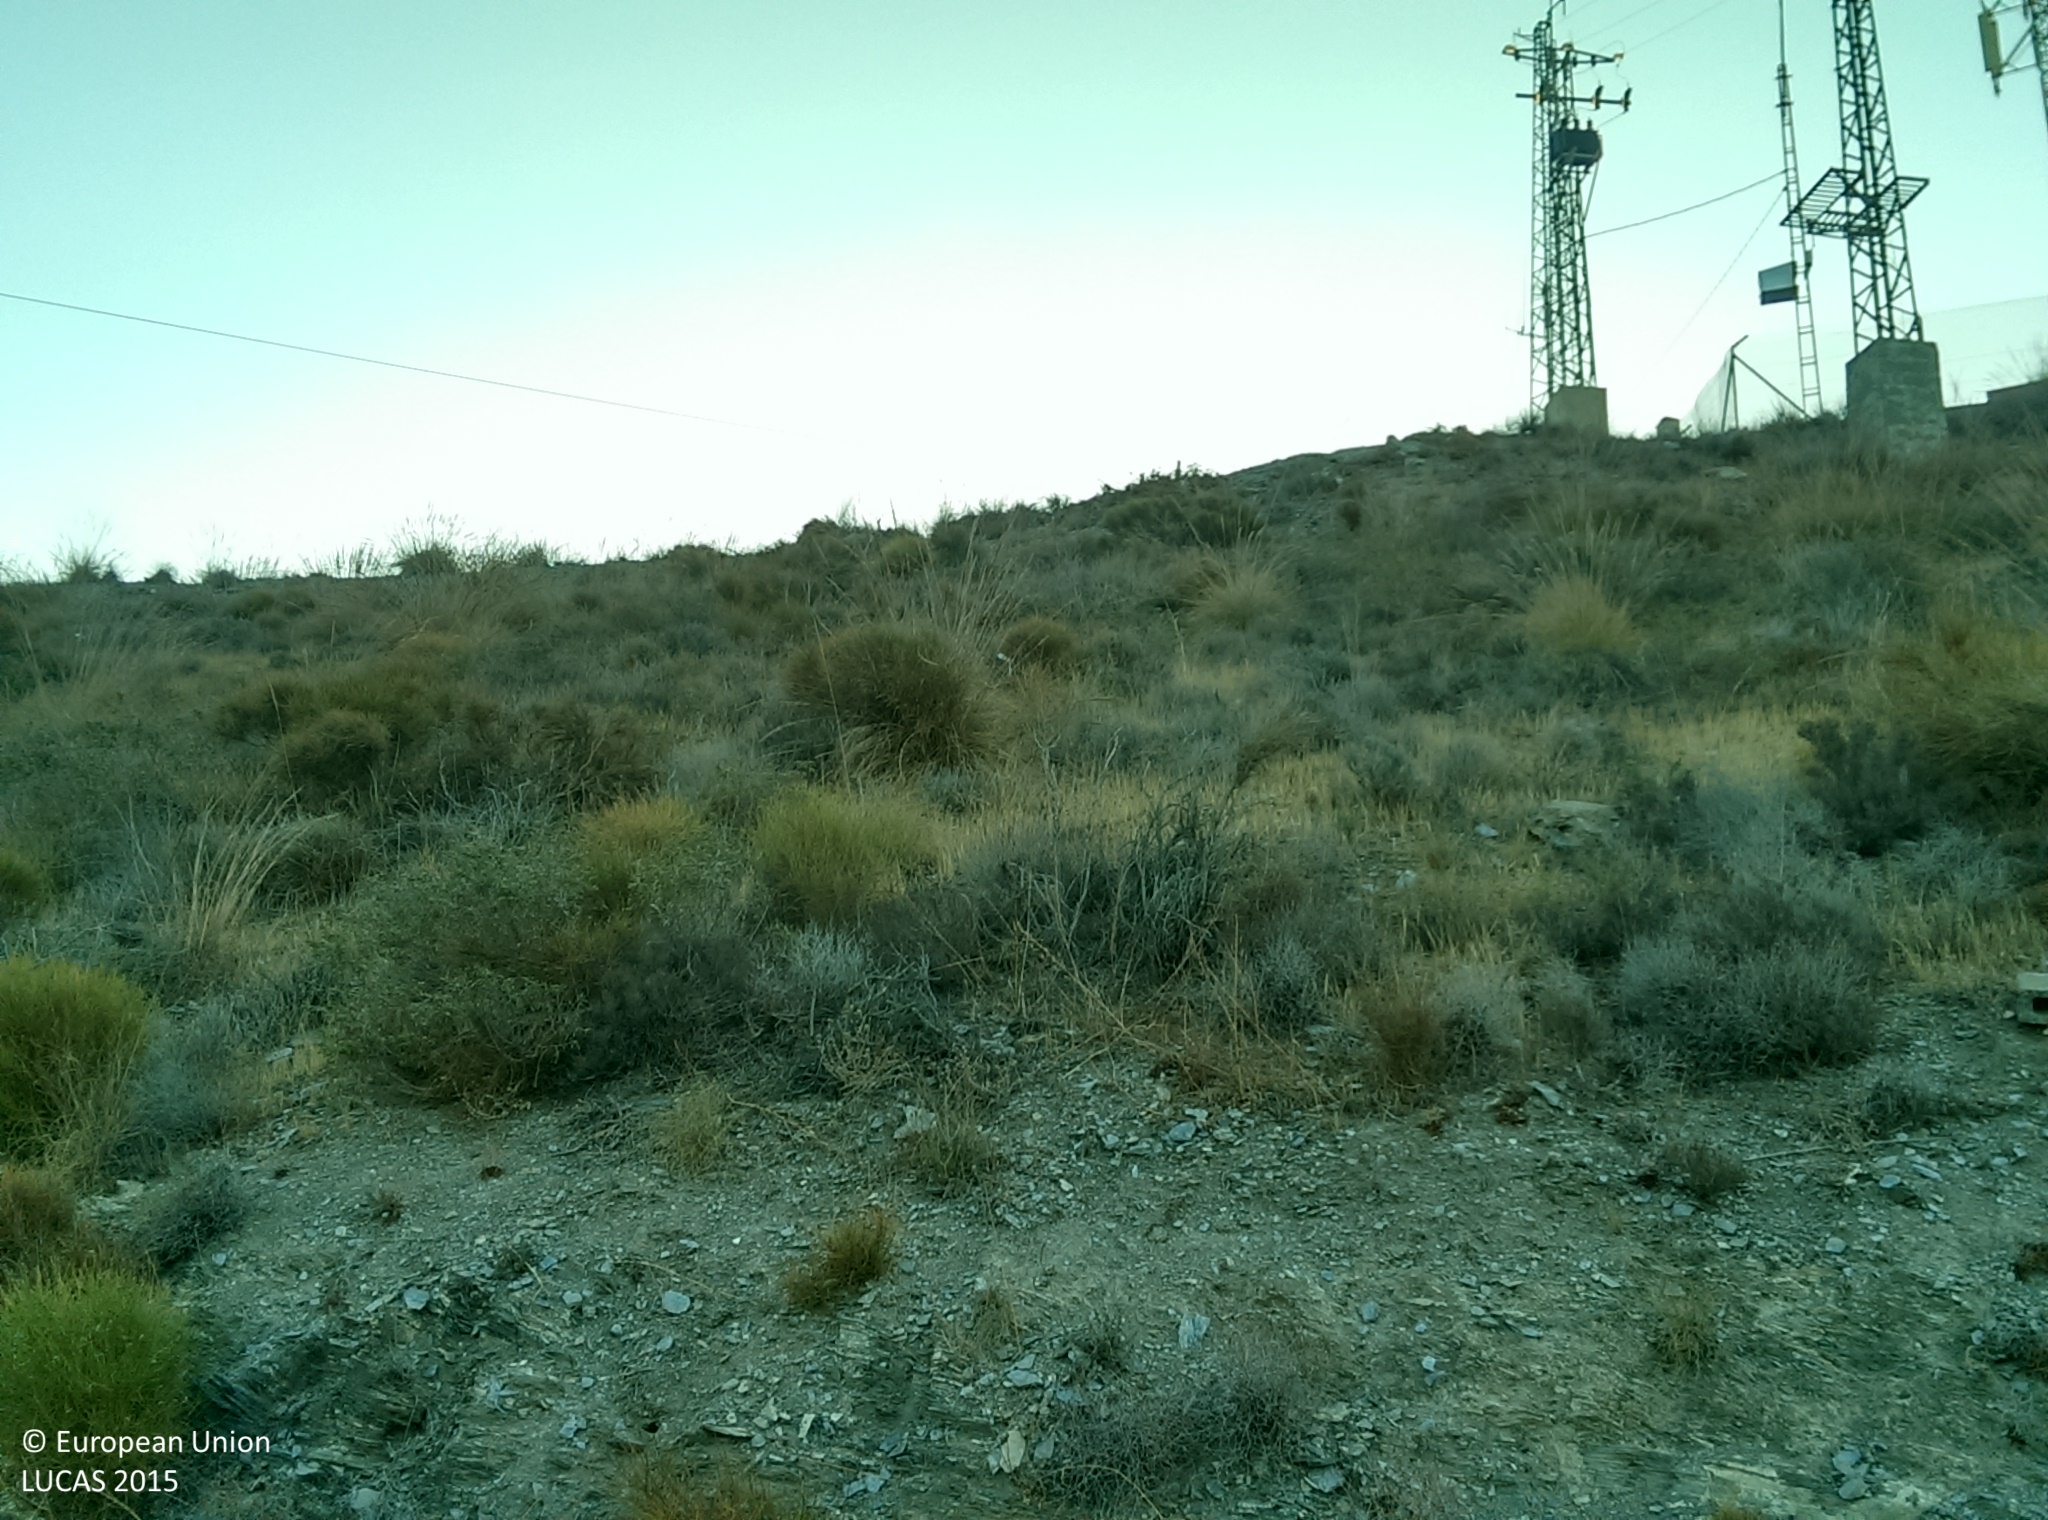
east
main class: Shrubland
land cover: Shrubland without tree cover
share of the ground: 25 - 50 %
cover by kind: shrubs 40 %, herbaceous plants 30 %, unconsolidated bare surface 30 %
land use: Abandoned areas
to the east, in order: Shrubland without tree cover; Electric lines; Tracks; Shrubland without tree cover; Electric lines; Shrubland without tree cover; Electric lines; Shrubland without tree cover; Fences; Shrubland without tree cover; Artificial constructions in urban areas; Fences; Shrubland without tree cover; Tracks; Shrubland without tree cover
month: August
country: ES
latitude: 36.7549
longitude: -3.1624
